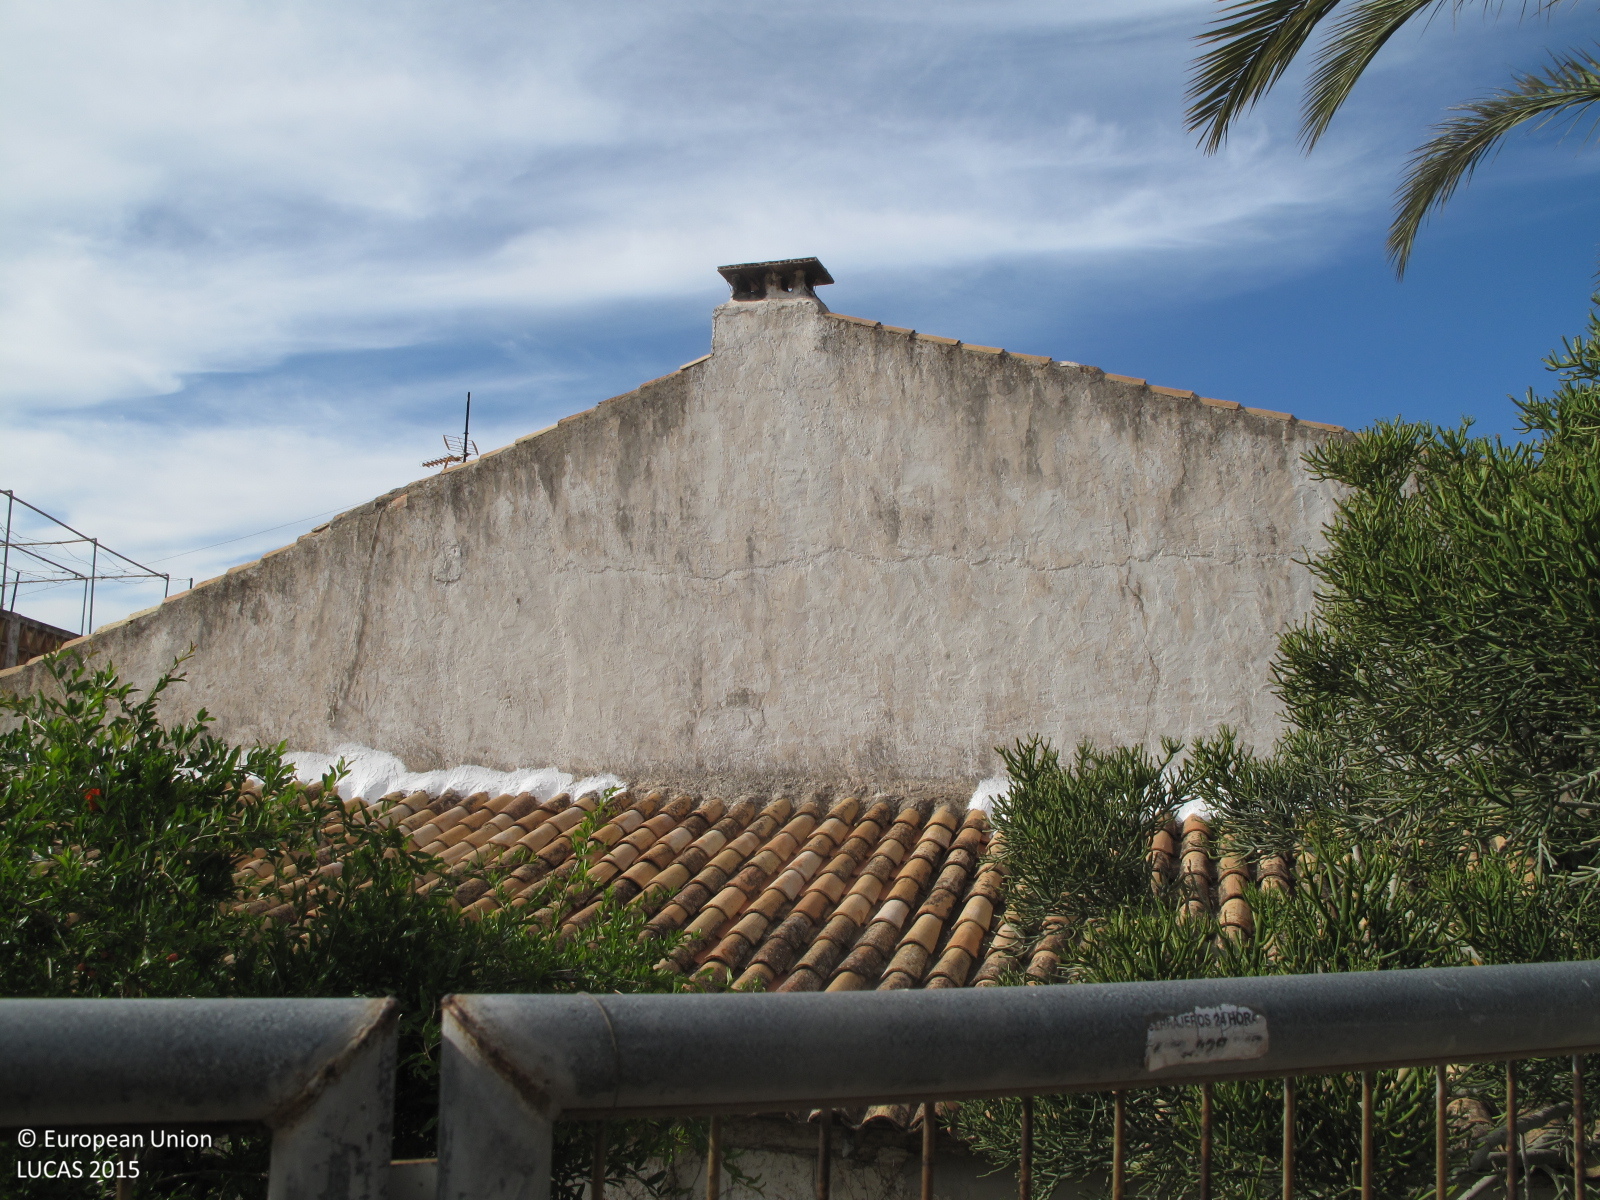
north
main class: Grassland
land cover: Grassland with sparse tree/shrub cover
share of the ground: > 75 %
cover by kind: herbaceous plants 95 %, broadleaved forest trees 5 %
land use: Residential
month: May
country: ES
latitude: 38.7920
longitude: 0.0296
